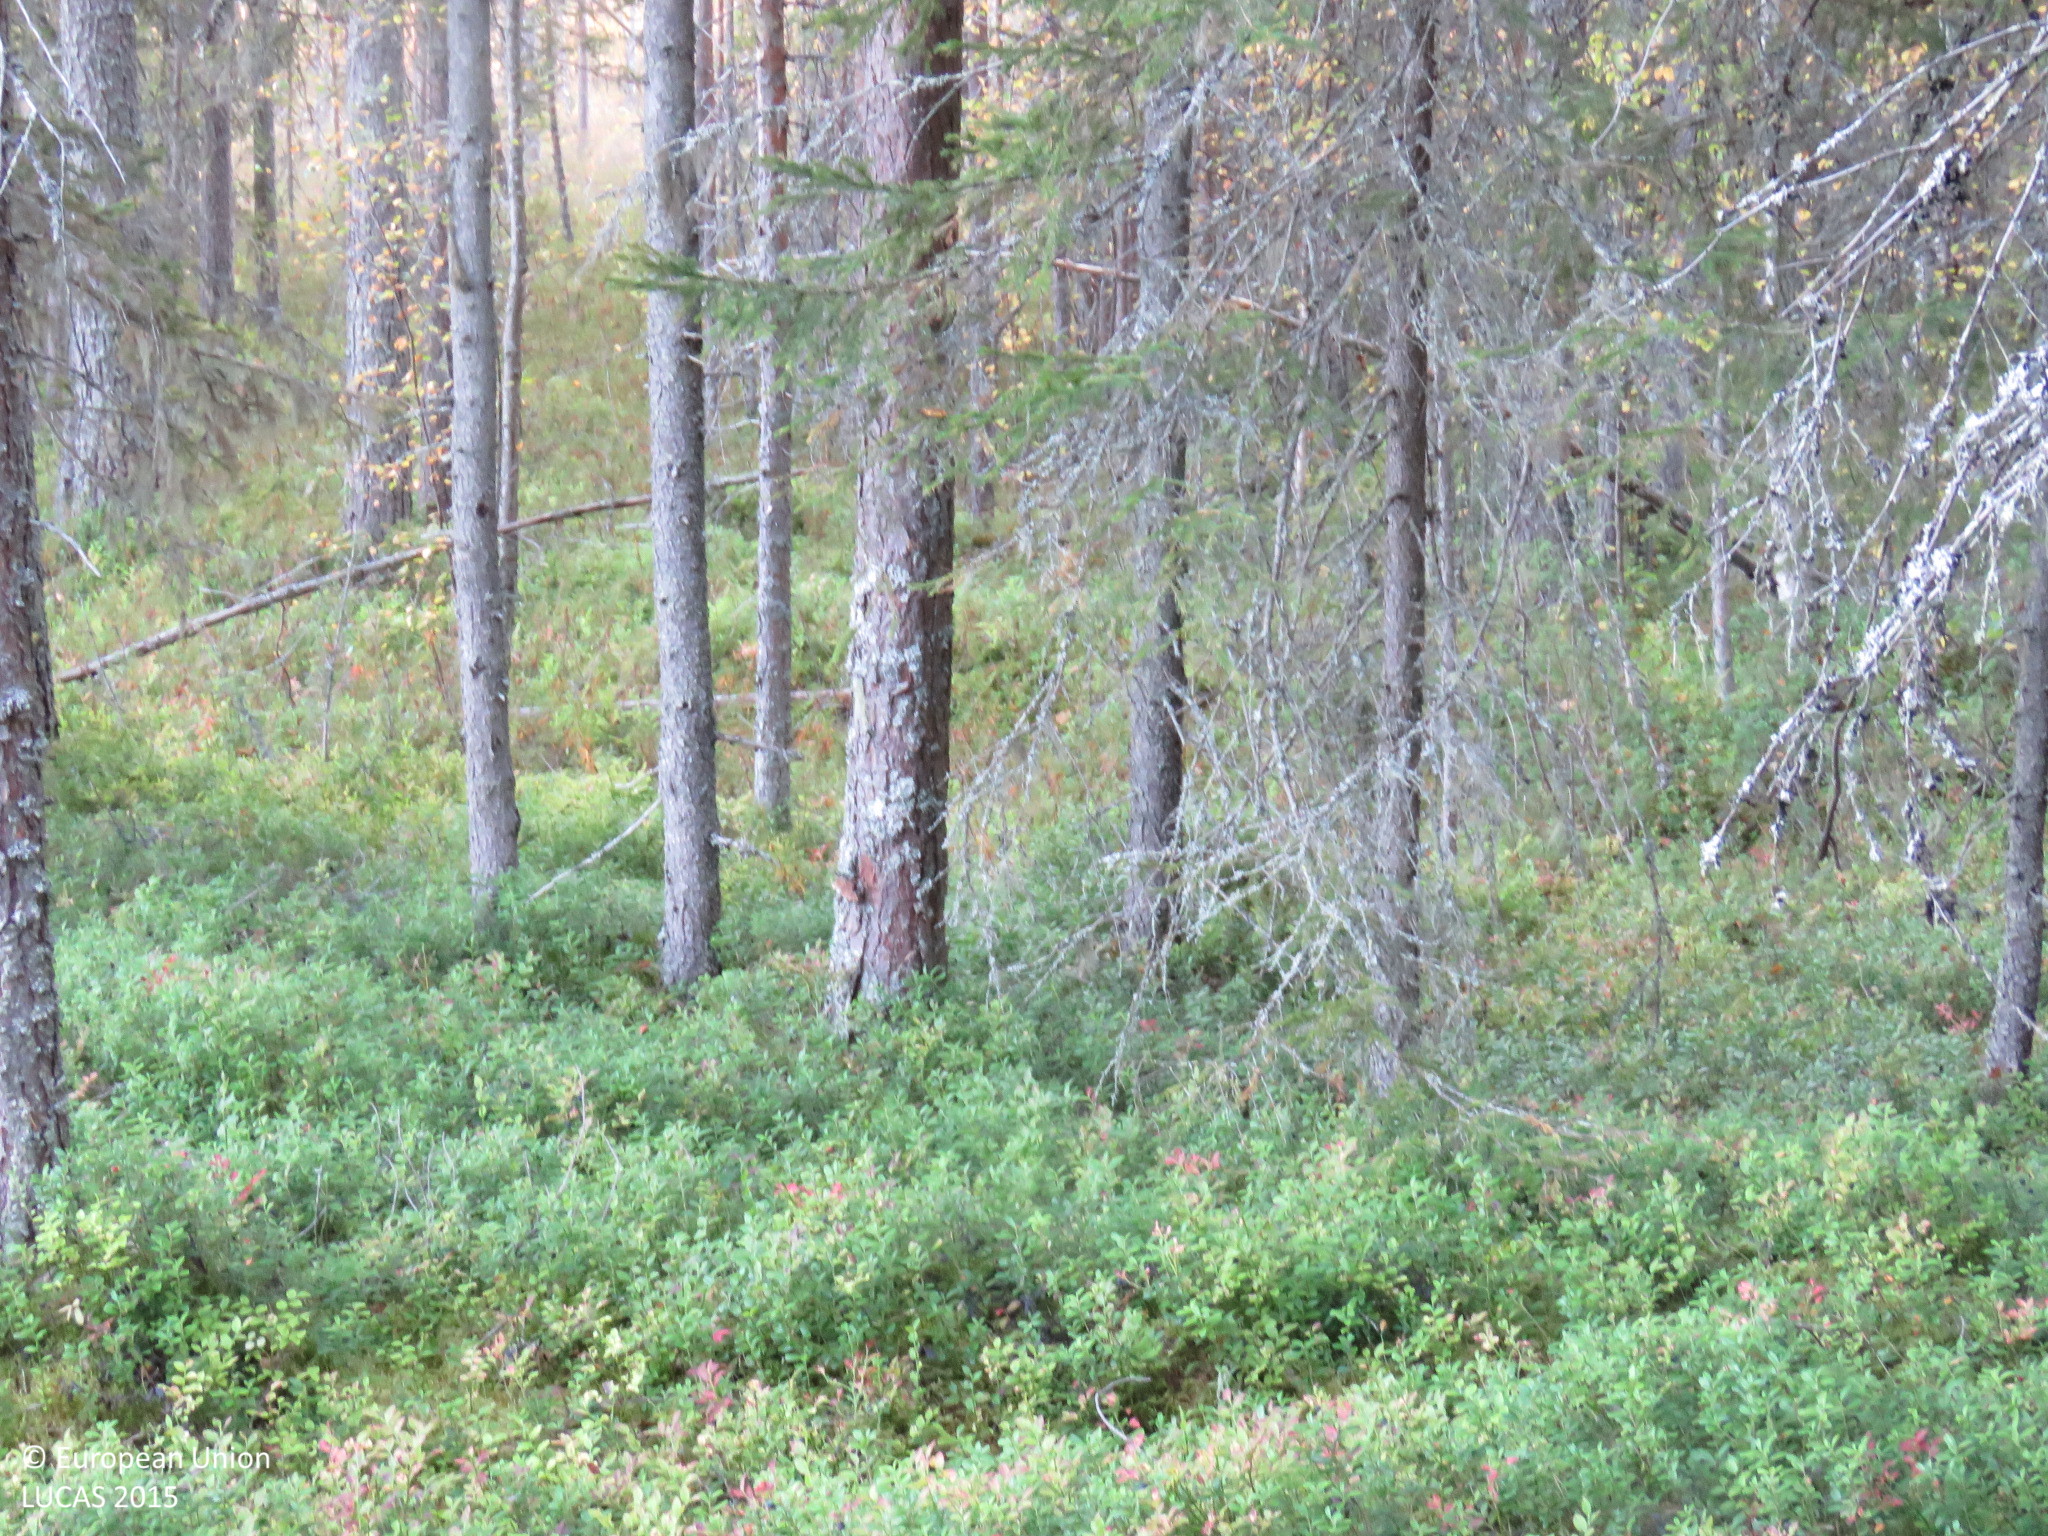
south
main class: Woodland
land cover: Other coniferous woodland
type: boreal forest
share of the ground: > 75 %
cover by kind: coniferous forest trees 70 %, shrubs 15 %, broadleaved forest trees 10 %, lichens and mosses 5 %
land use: Forestry
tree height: > 5 m
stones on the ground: < 10 %
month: September
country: FI
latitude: 65.0389
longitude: 26.3940
